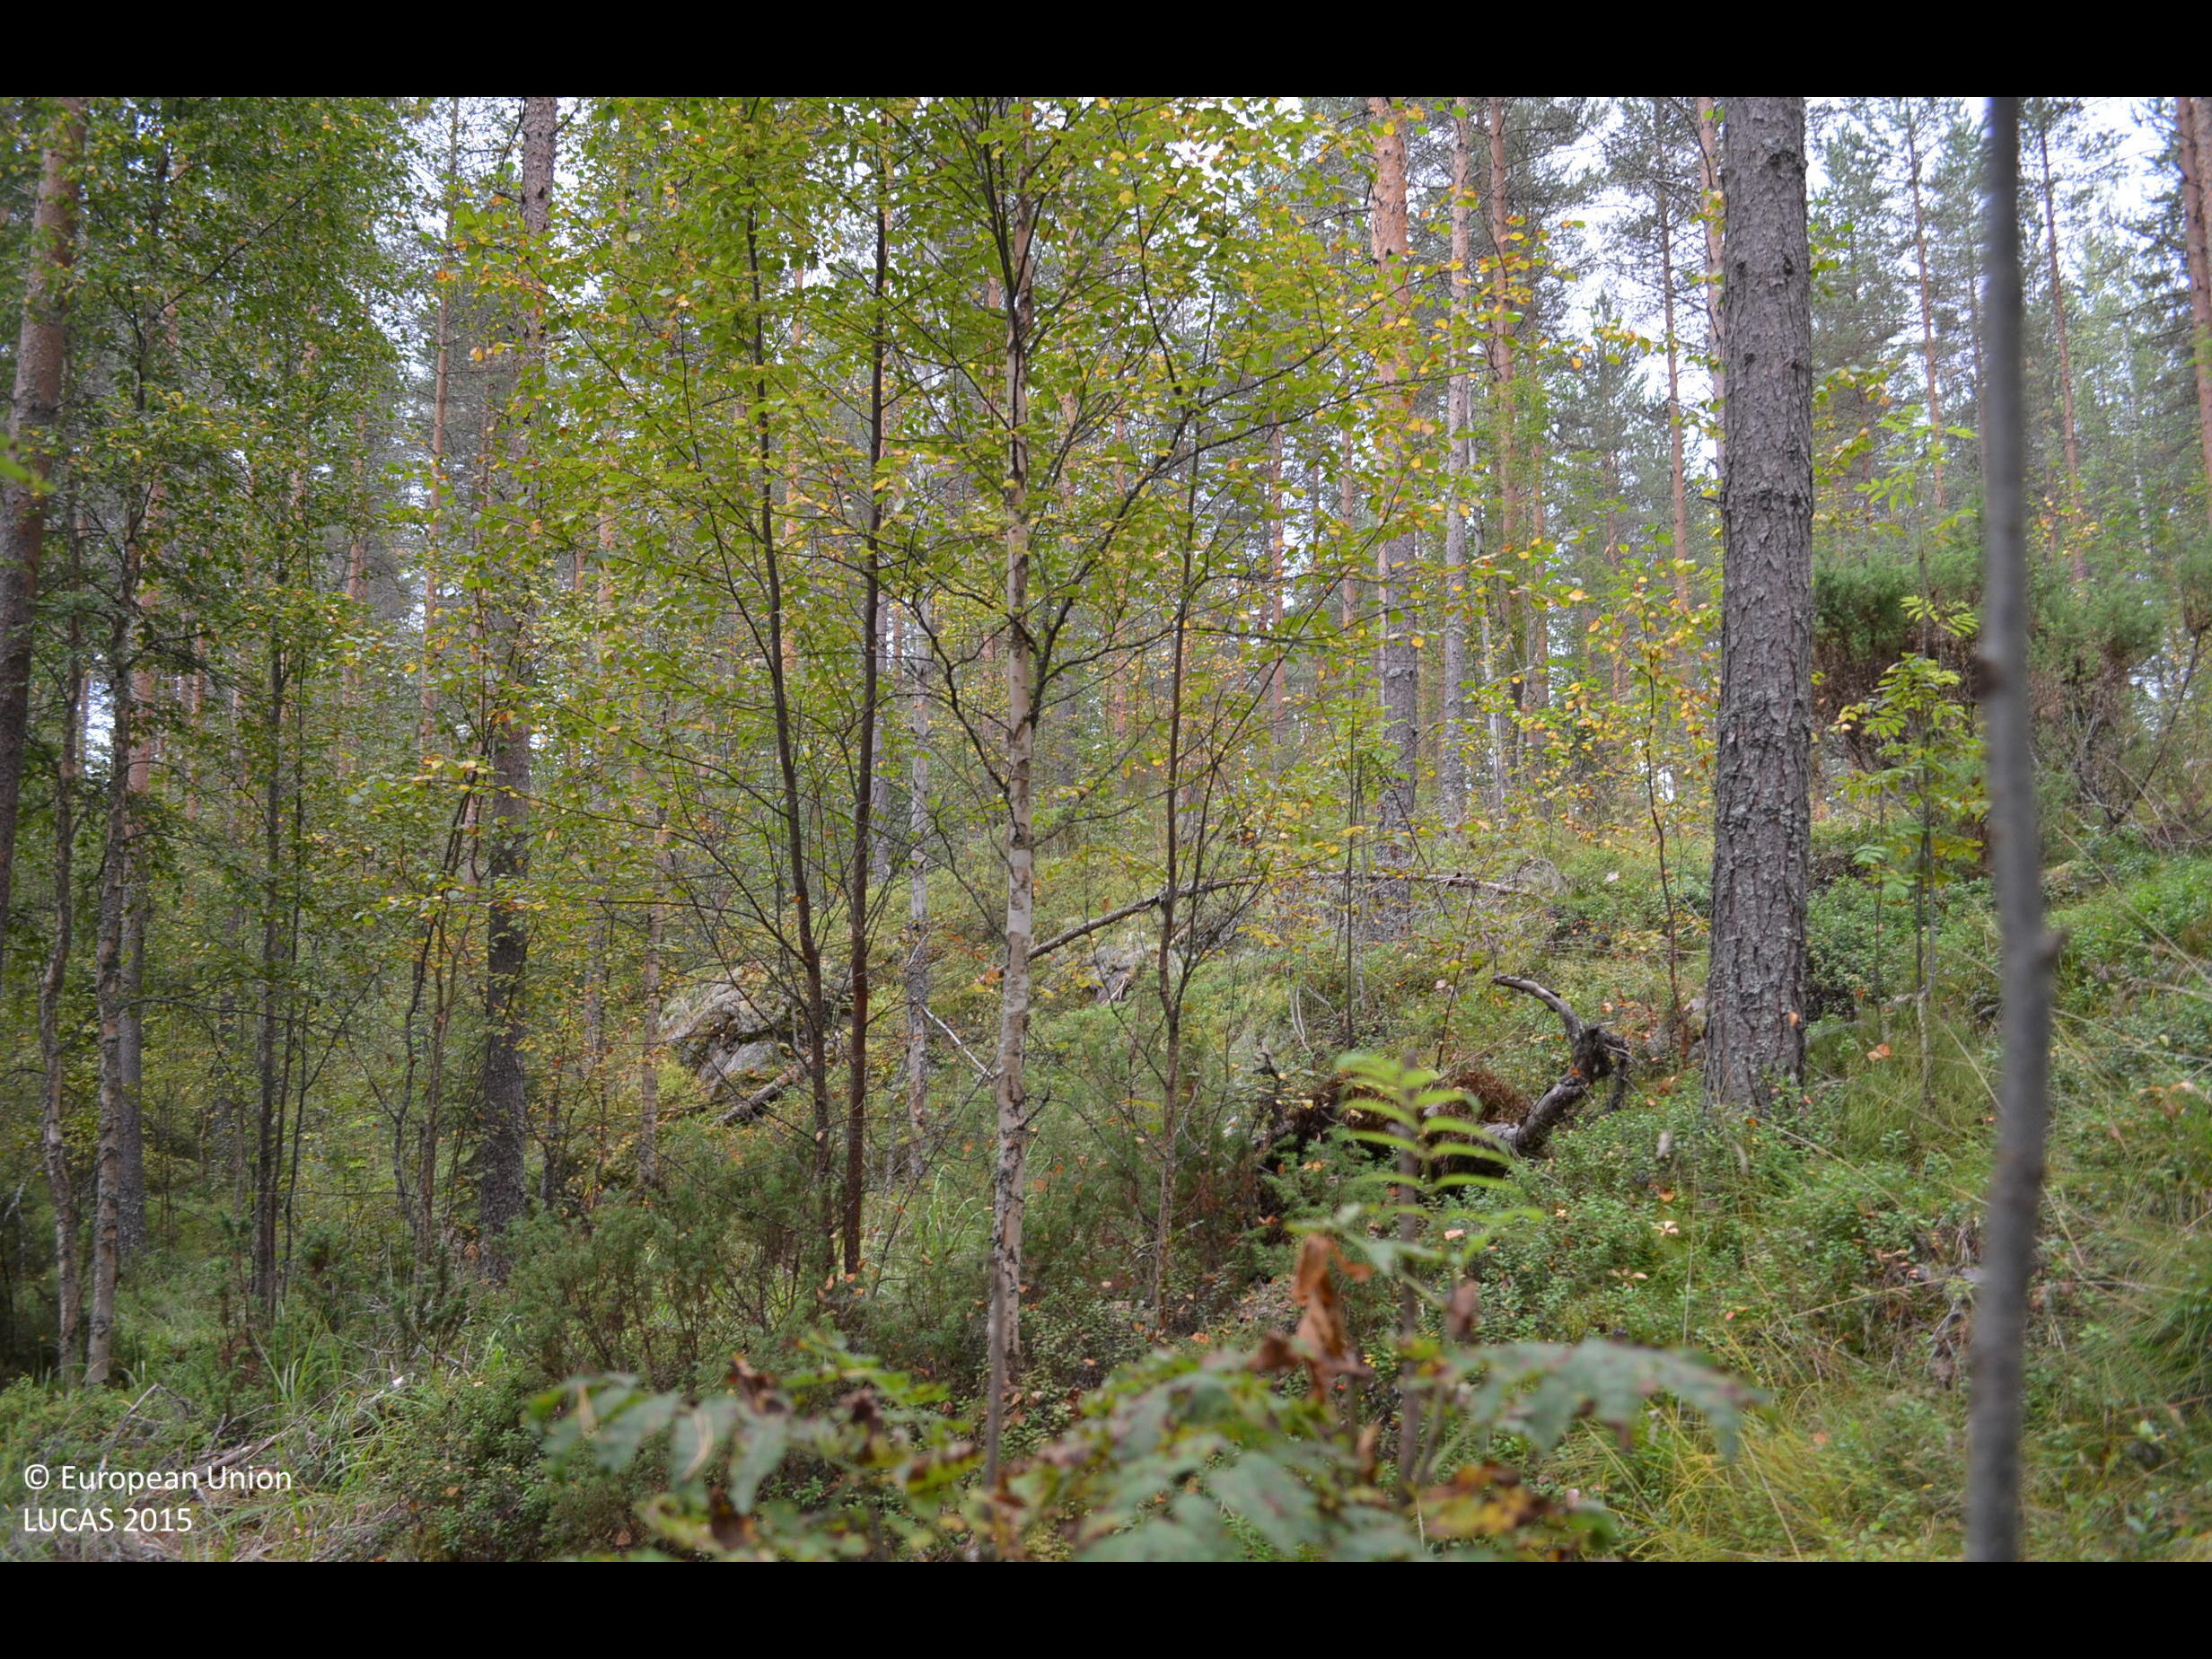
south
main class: Woodland
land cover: Pine dominated mixed woodland
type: boreal forest
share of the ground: 50 - 75 %
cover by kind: coniferous forest trees 50 %, broadleaved forest trees 20 %, shrubs 20 %, herbaceous plants 10 %
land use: Forestry
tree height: > 5 m
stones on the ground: < 10 %
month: August
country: FI
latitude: 62.4027
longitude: 23.7172
